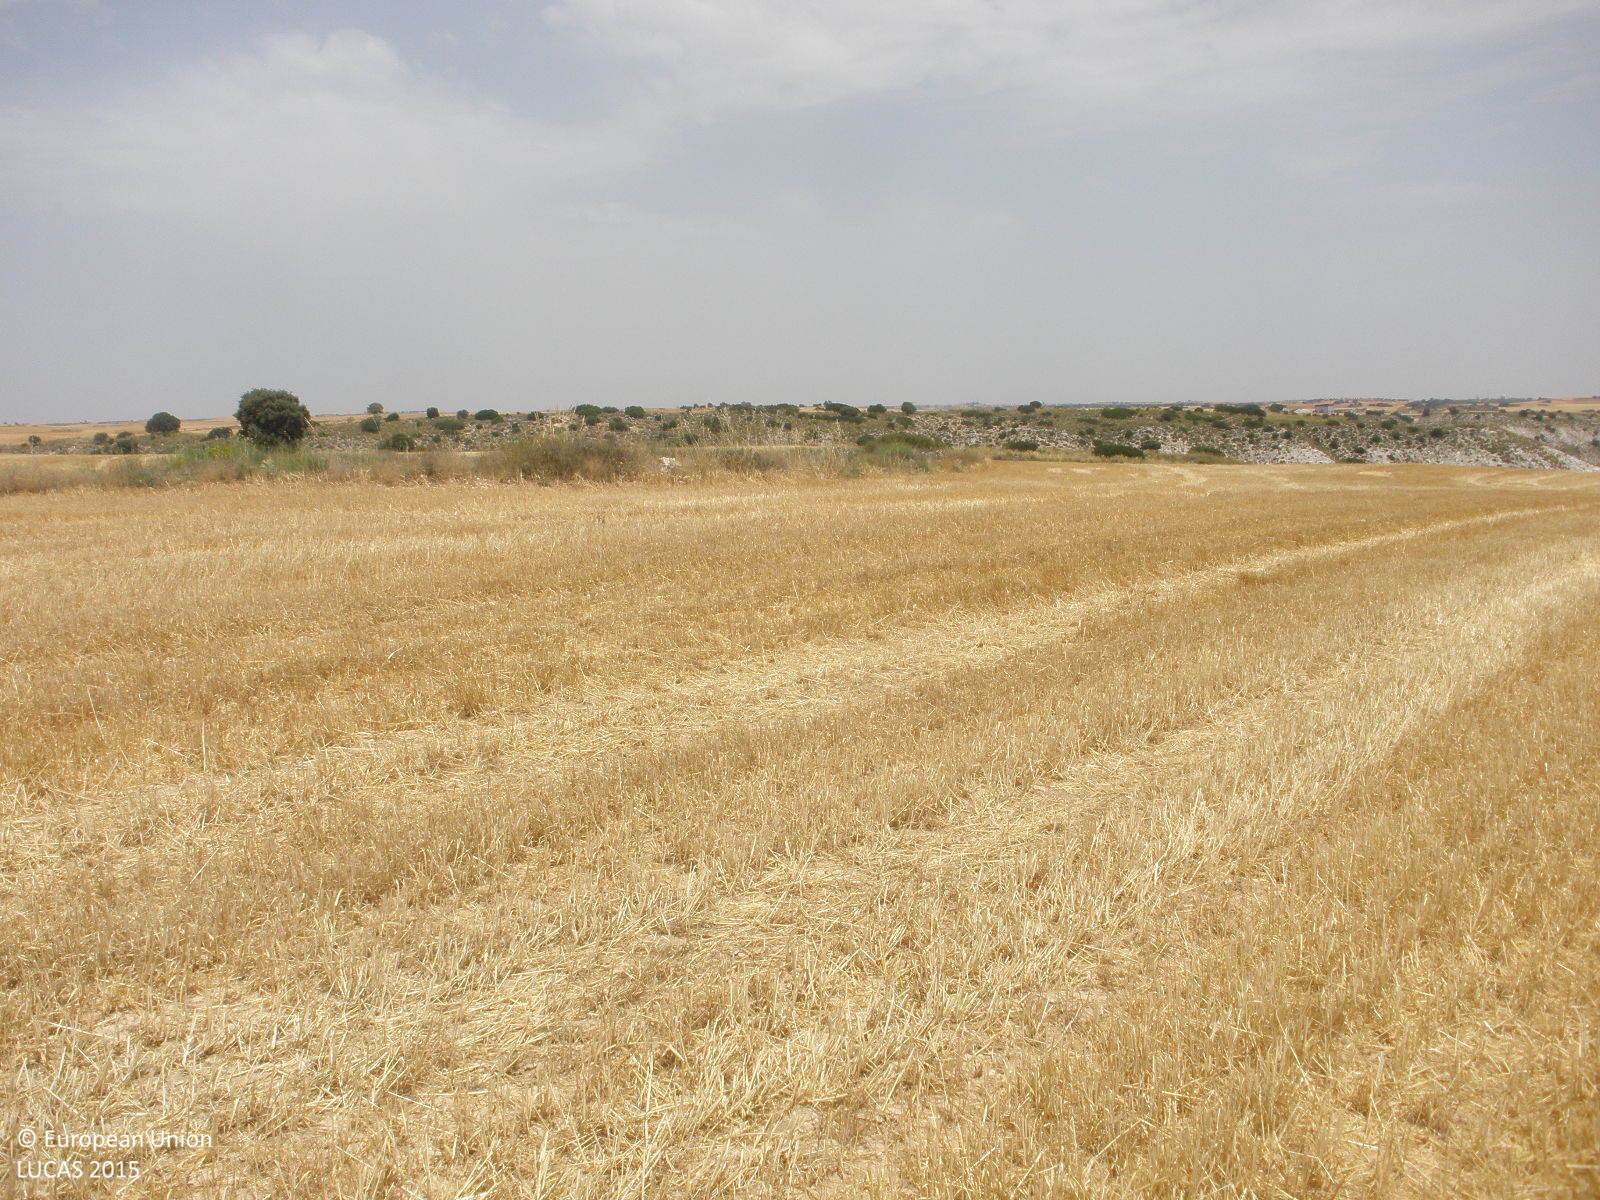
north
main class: Cropland
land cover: Barley
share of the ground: < 10 %
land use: Agriculture (excluding fallow land and kitchen gardens)
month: July
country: ES
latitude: 39.8403
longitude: -3.3831
